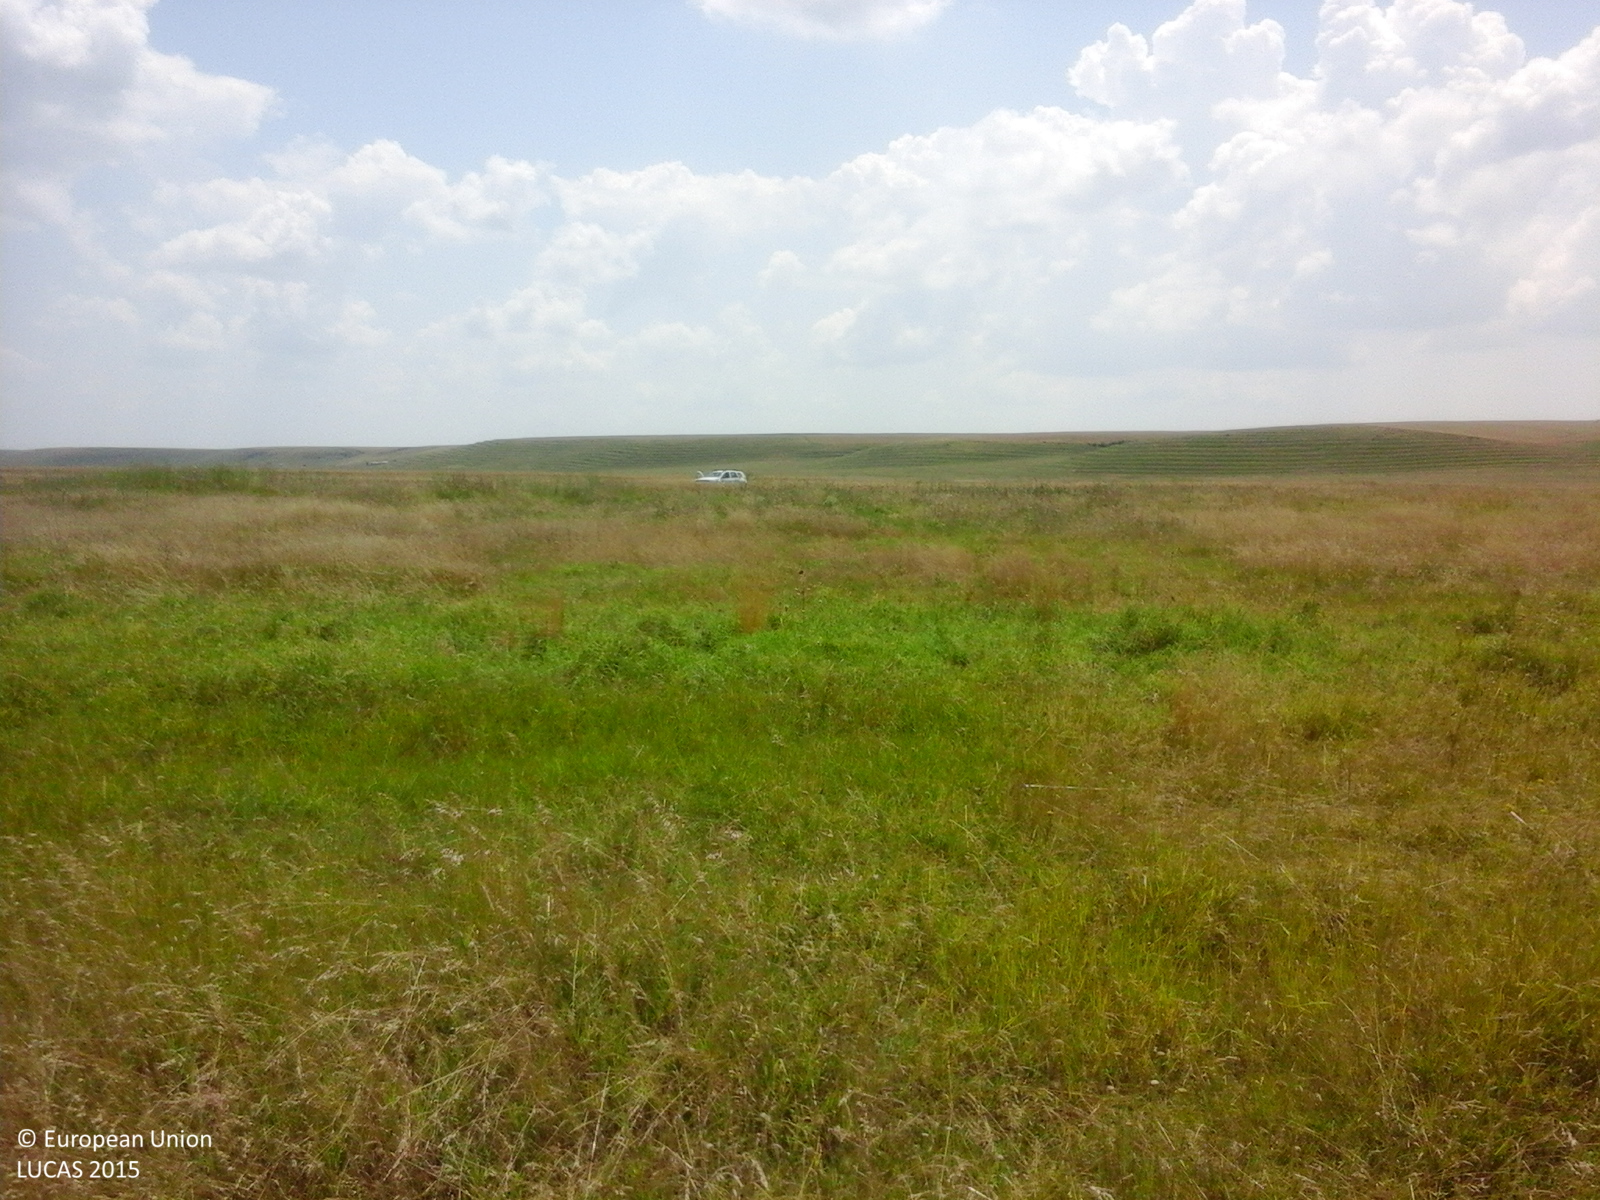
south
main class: Grassland
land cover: Grassland without tree/shrub cover
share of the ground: > 75 %
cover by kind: herbaceous plants 100 %
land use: Agriculture (excluding fallow land and kitchen gardens)
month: July
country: RO
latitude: 44.0441
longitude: 25.3471
